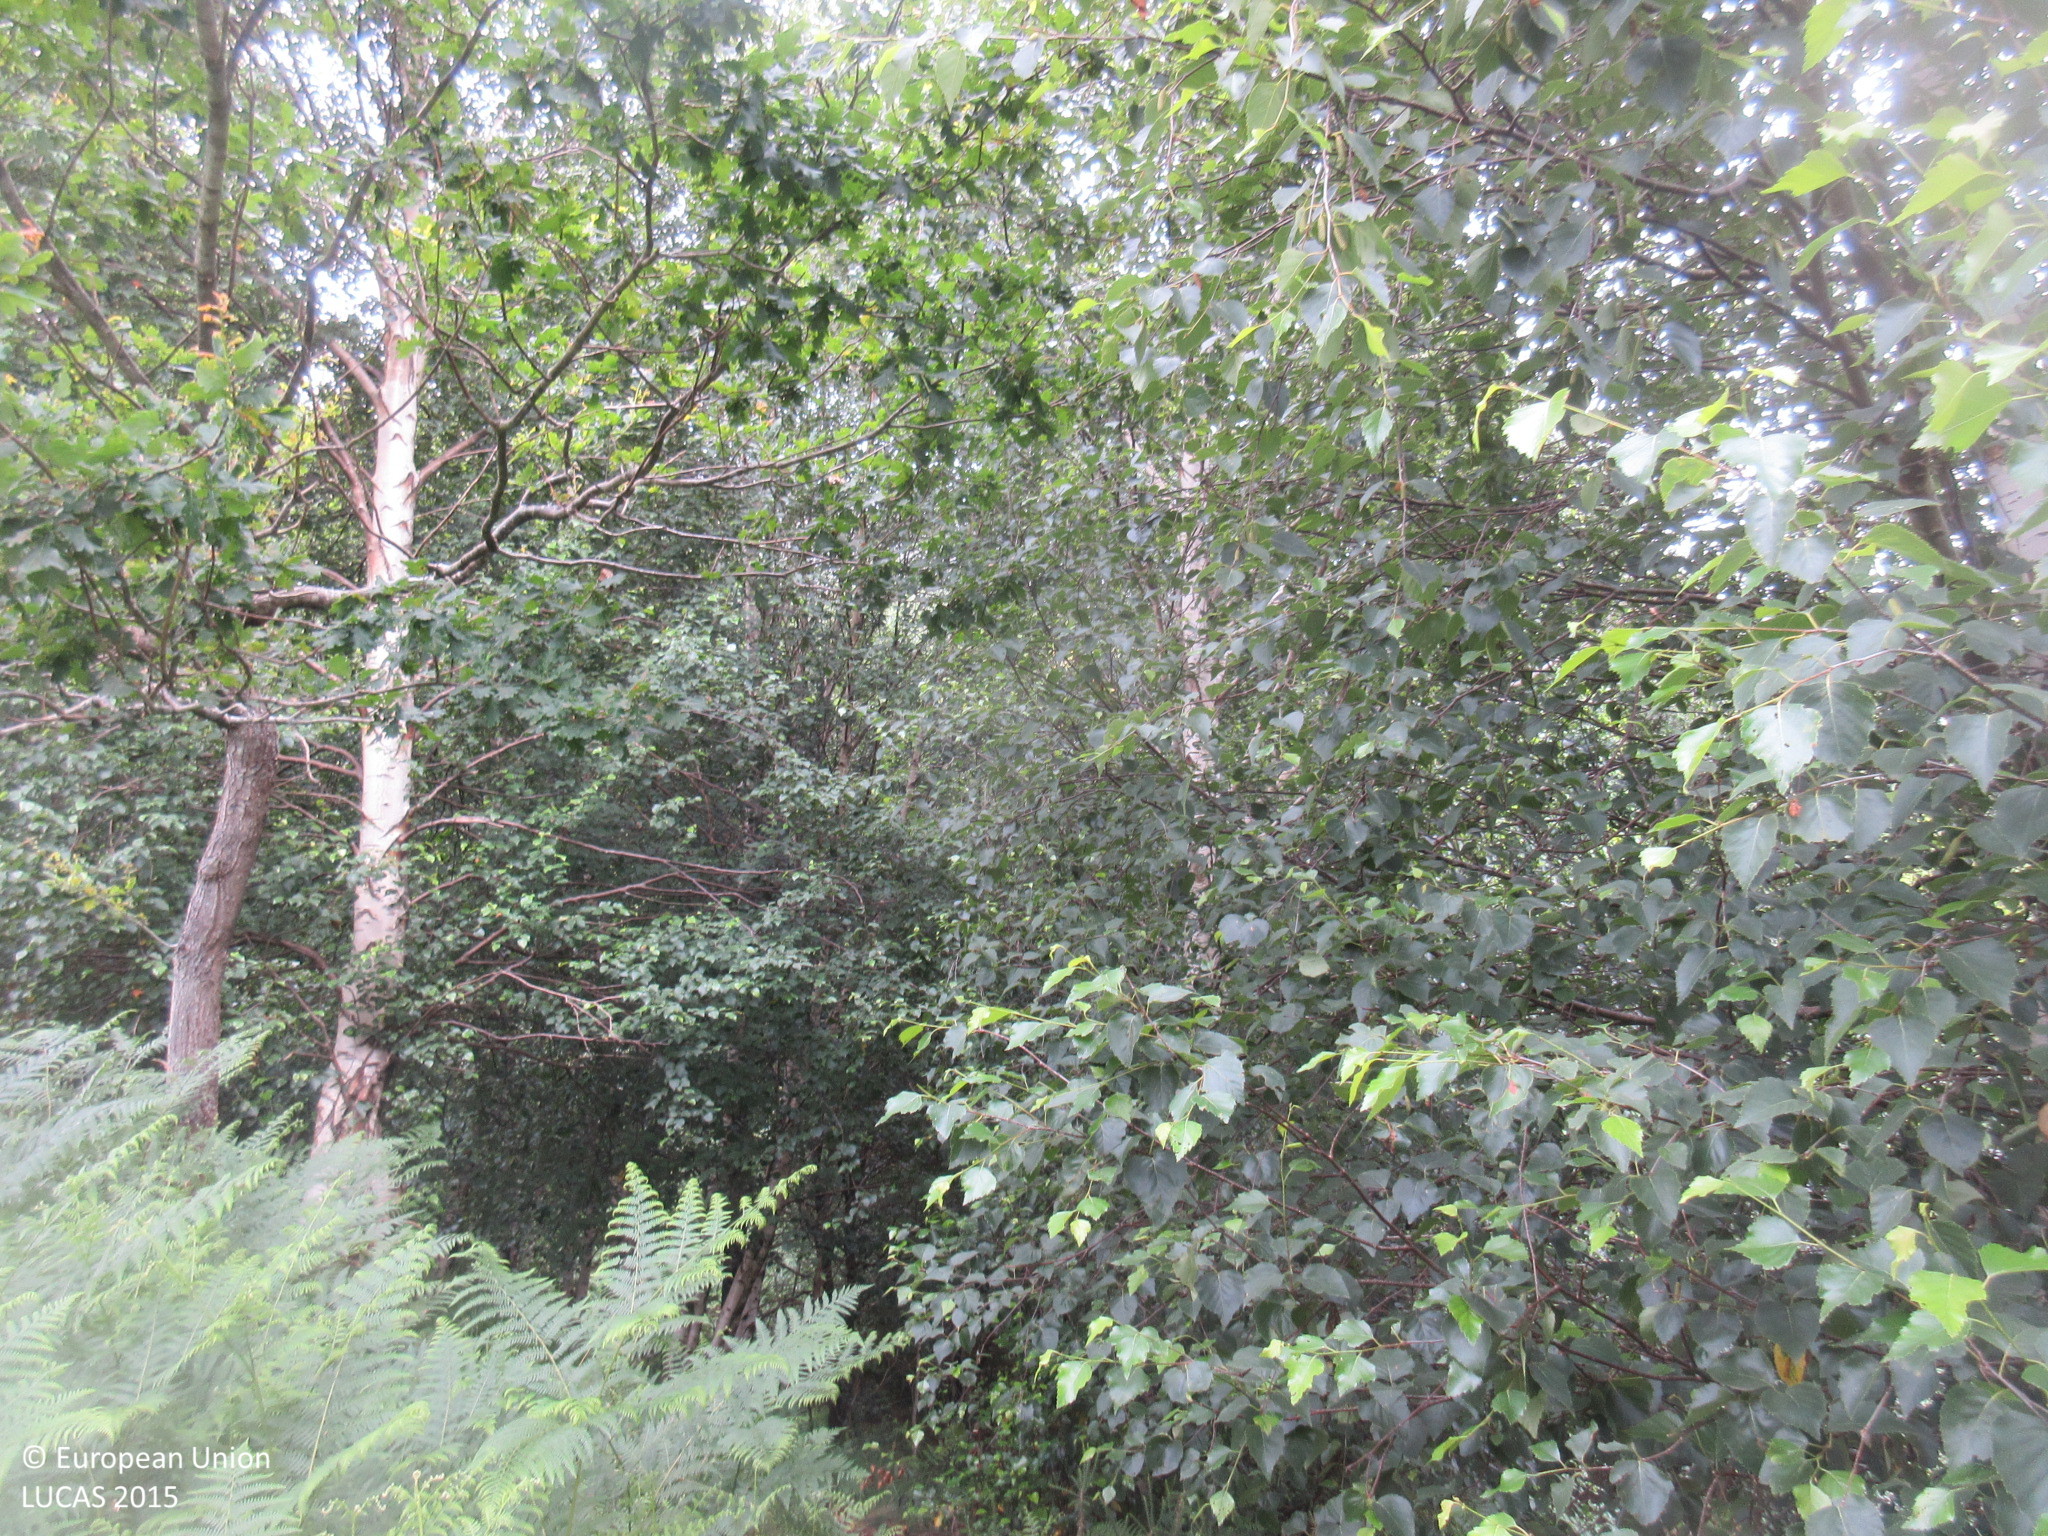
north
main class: Woodland
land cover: Broadleaved woodland
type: acidophilous oak and oak-birch forest
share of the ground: 25 - 50 %
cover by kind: herbaceous plants 60 %, broadleaved forest trees 40 %
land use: Semi-natural and natural areas not in use
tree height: > 5 m
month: July
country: ES
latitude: 43.2263
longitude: -3.4991
